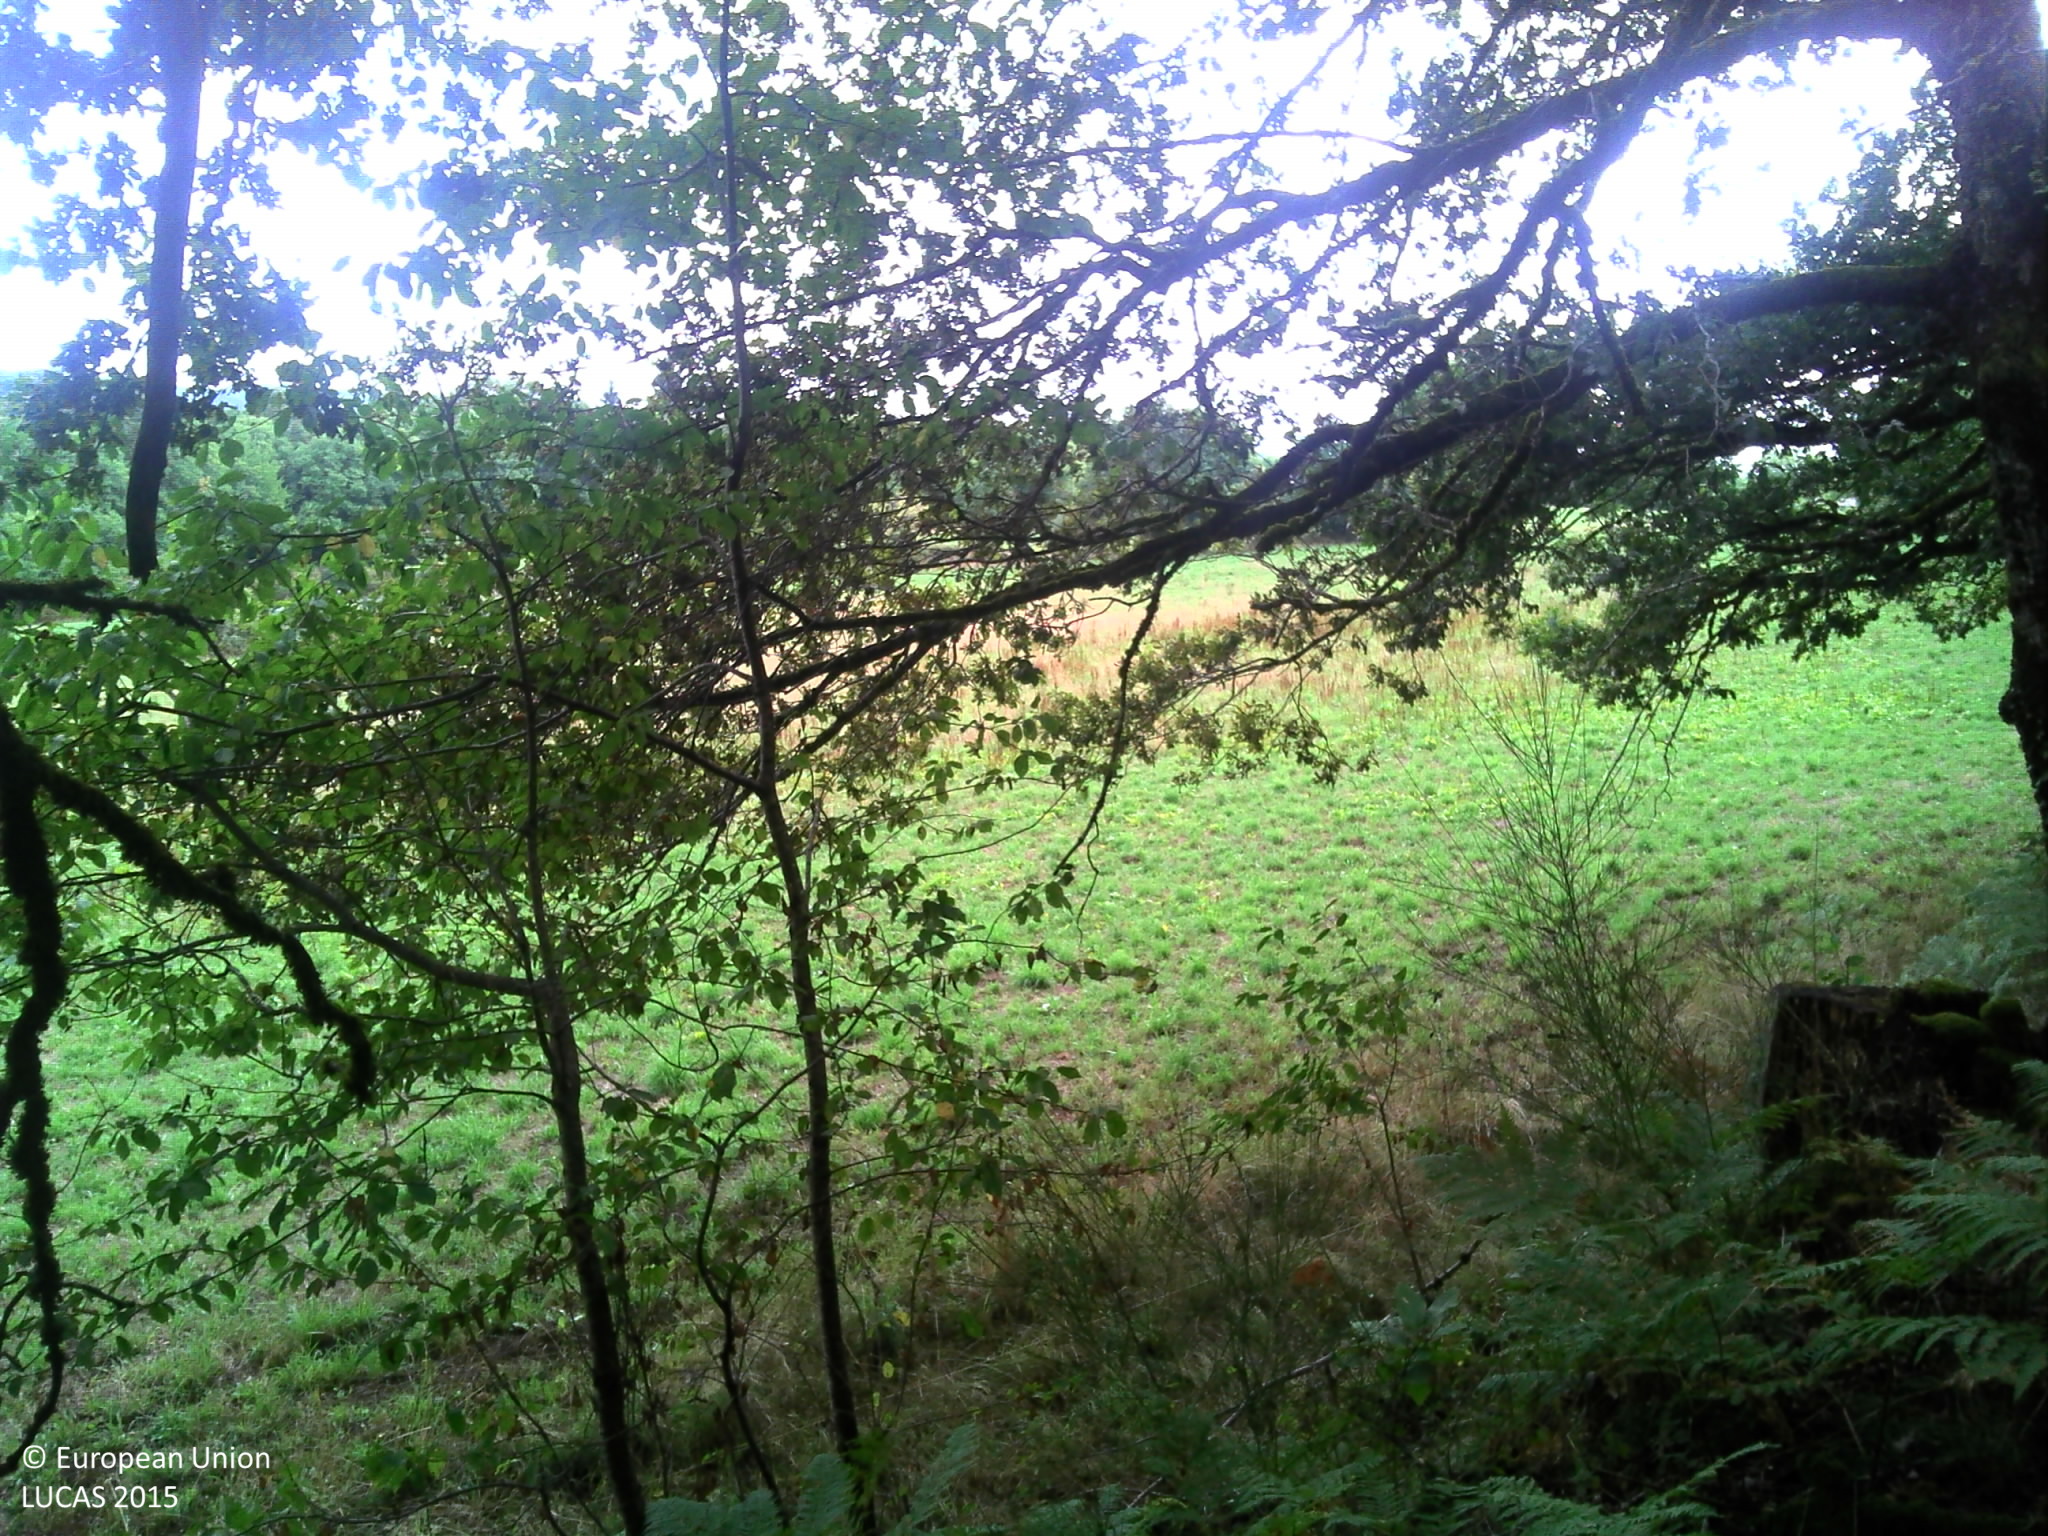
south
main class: Woodland
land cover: Broadleaved woodland
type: thermophilous deciduous forest
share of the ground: > 75 %
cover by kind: broadleaved forest trees 60 %, herbaceous plants 40 %
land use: Forestry
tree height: > 5 m
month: August
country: FR
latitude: 45.4406
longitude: 1.8265
